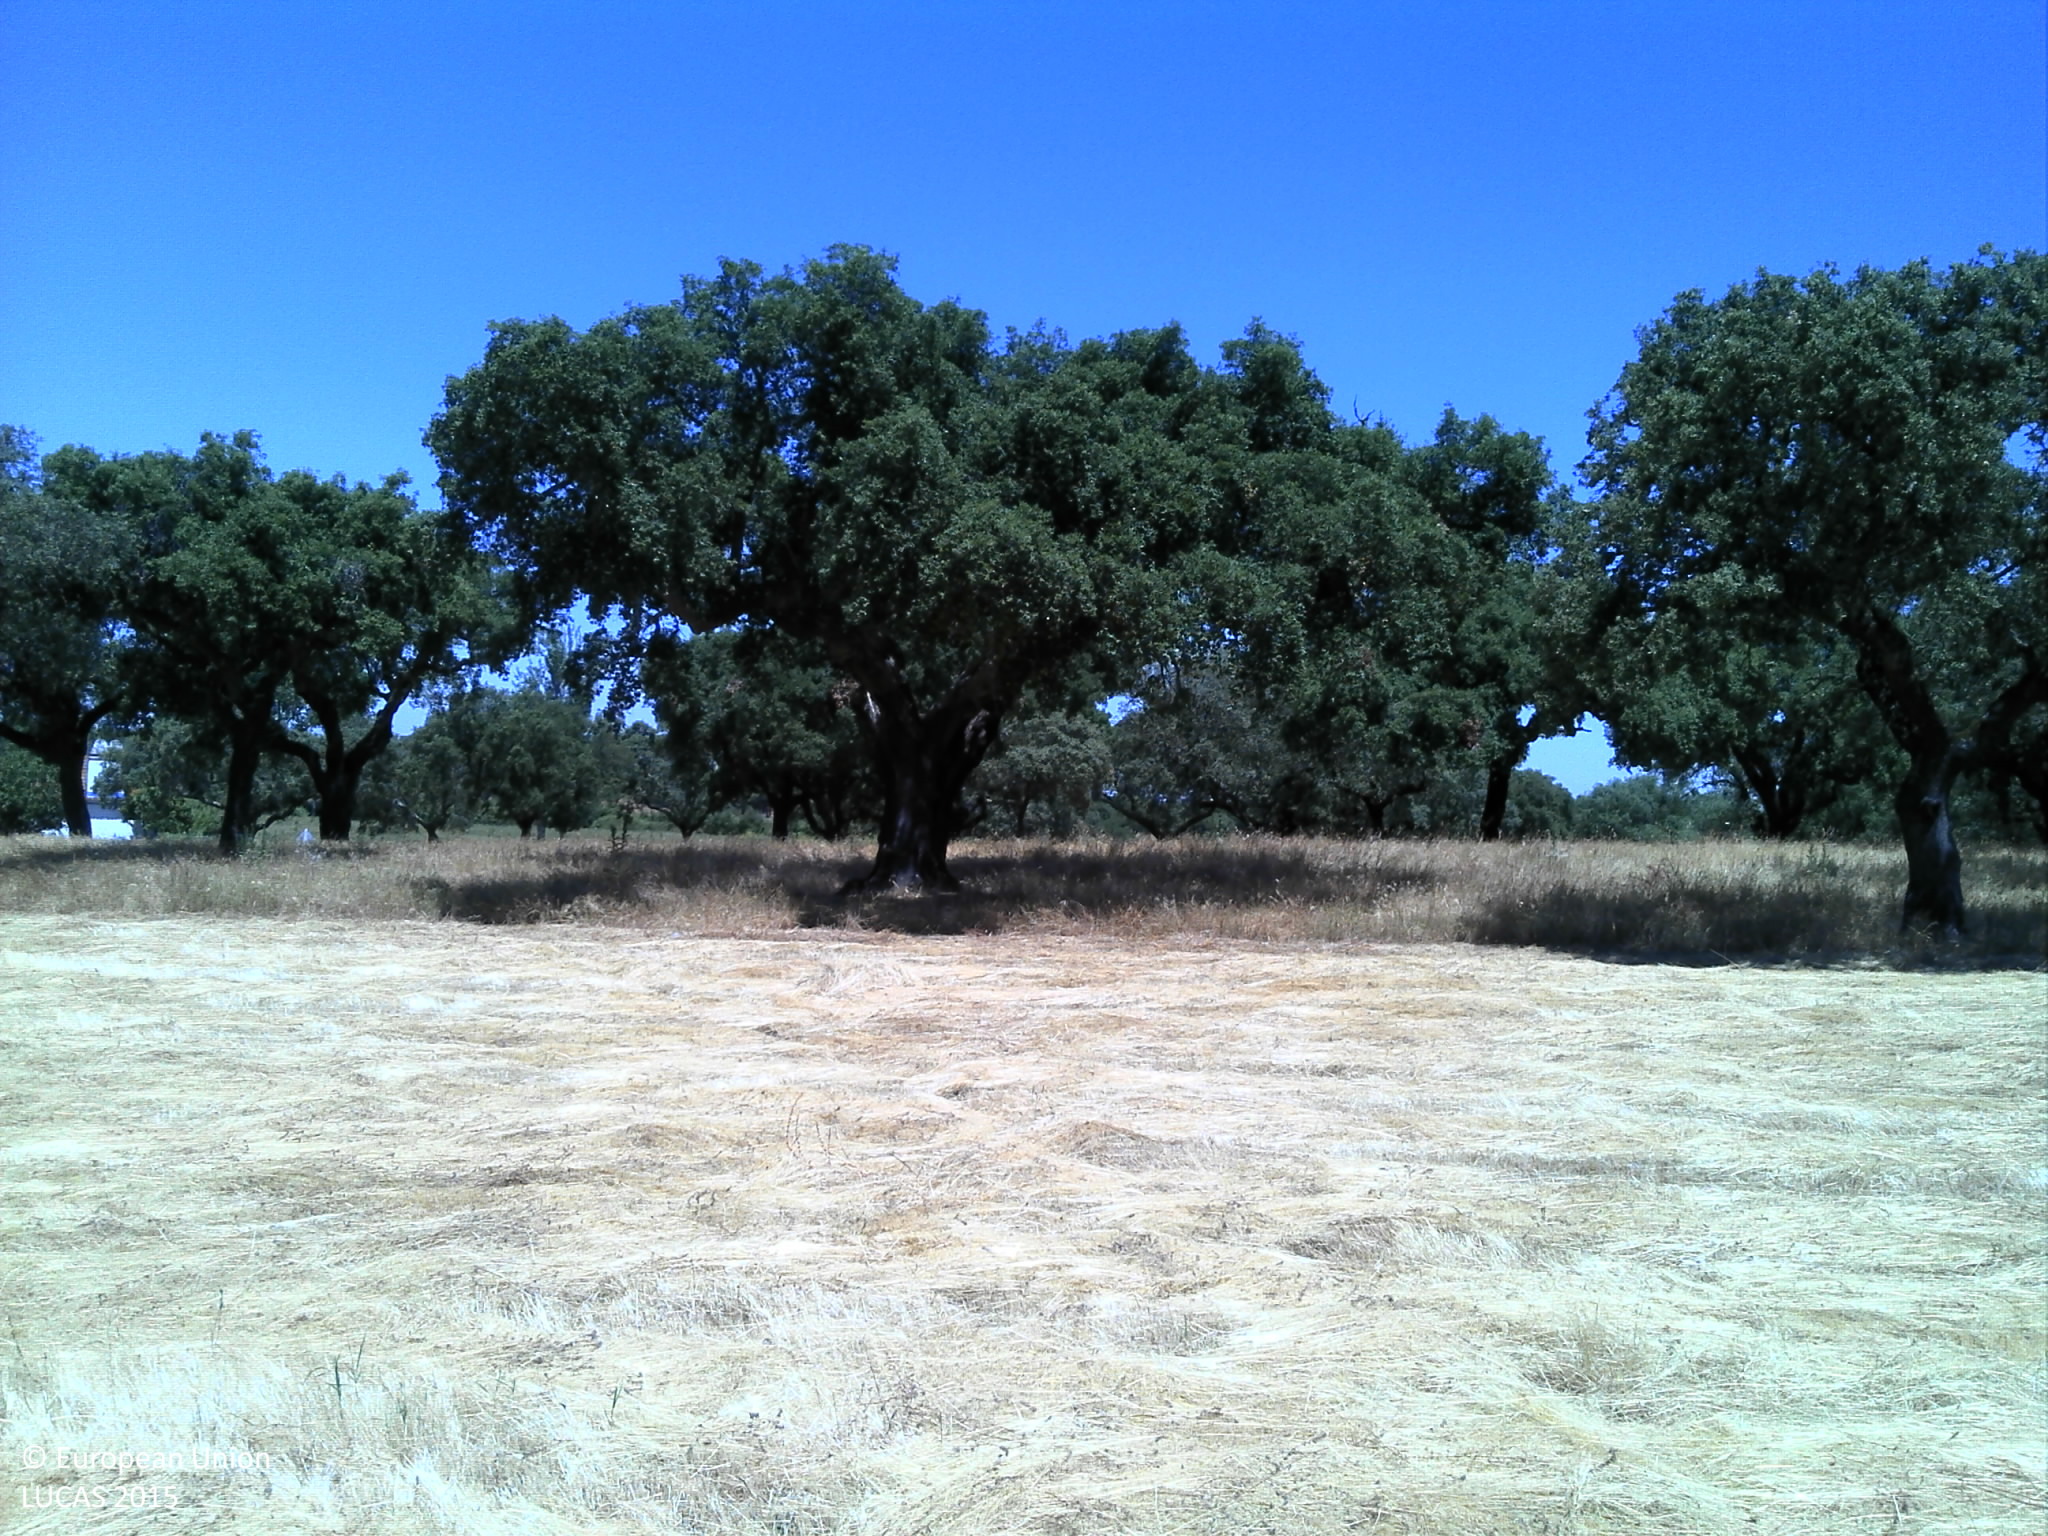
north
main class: Woodland
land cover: Broadleaved woodland
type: broadleaved evergreen forest
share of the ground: 10 - 25 %
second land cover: Grassland without tree/shrub cover
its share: 50 - 75 %
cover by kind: herbaceous plants 75 %, unconsolidated bare surface 15 %, broadleaved forest trees 10 %
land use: Forestry
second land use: Agriculture (excluding fallow land and kitchen gardens)
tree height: > 5 m
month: June
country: PT
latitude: 38.7135
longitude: -8.2089
